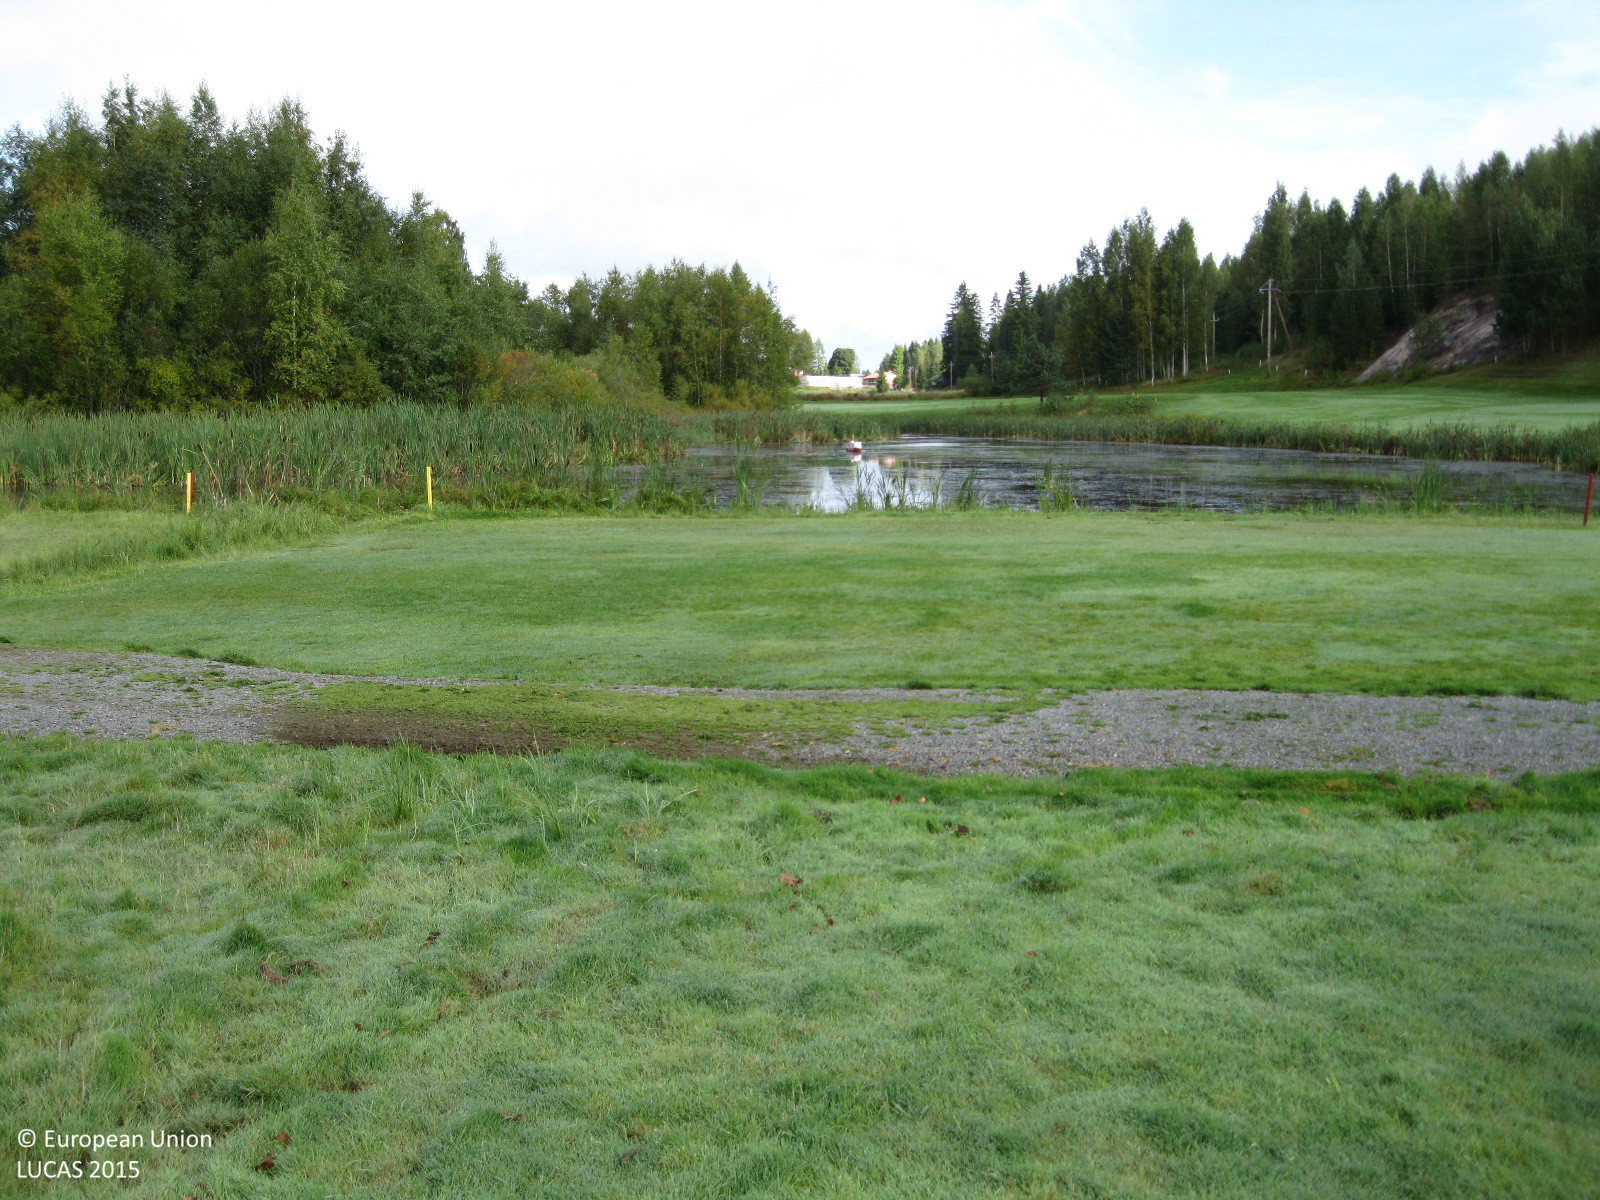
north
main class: Grassland
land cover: Grassland without tree/shrub cover
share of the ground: > 75 %
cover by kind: herbaceous plants 100 %
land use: Sport
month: September
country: FI
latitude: 60.5001
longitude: 24.5815
